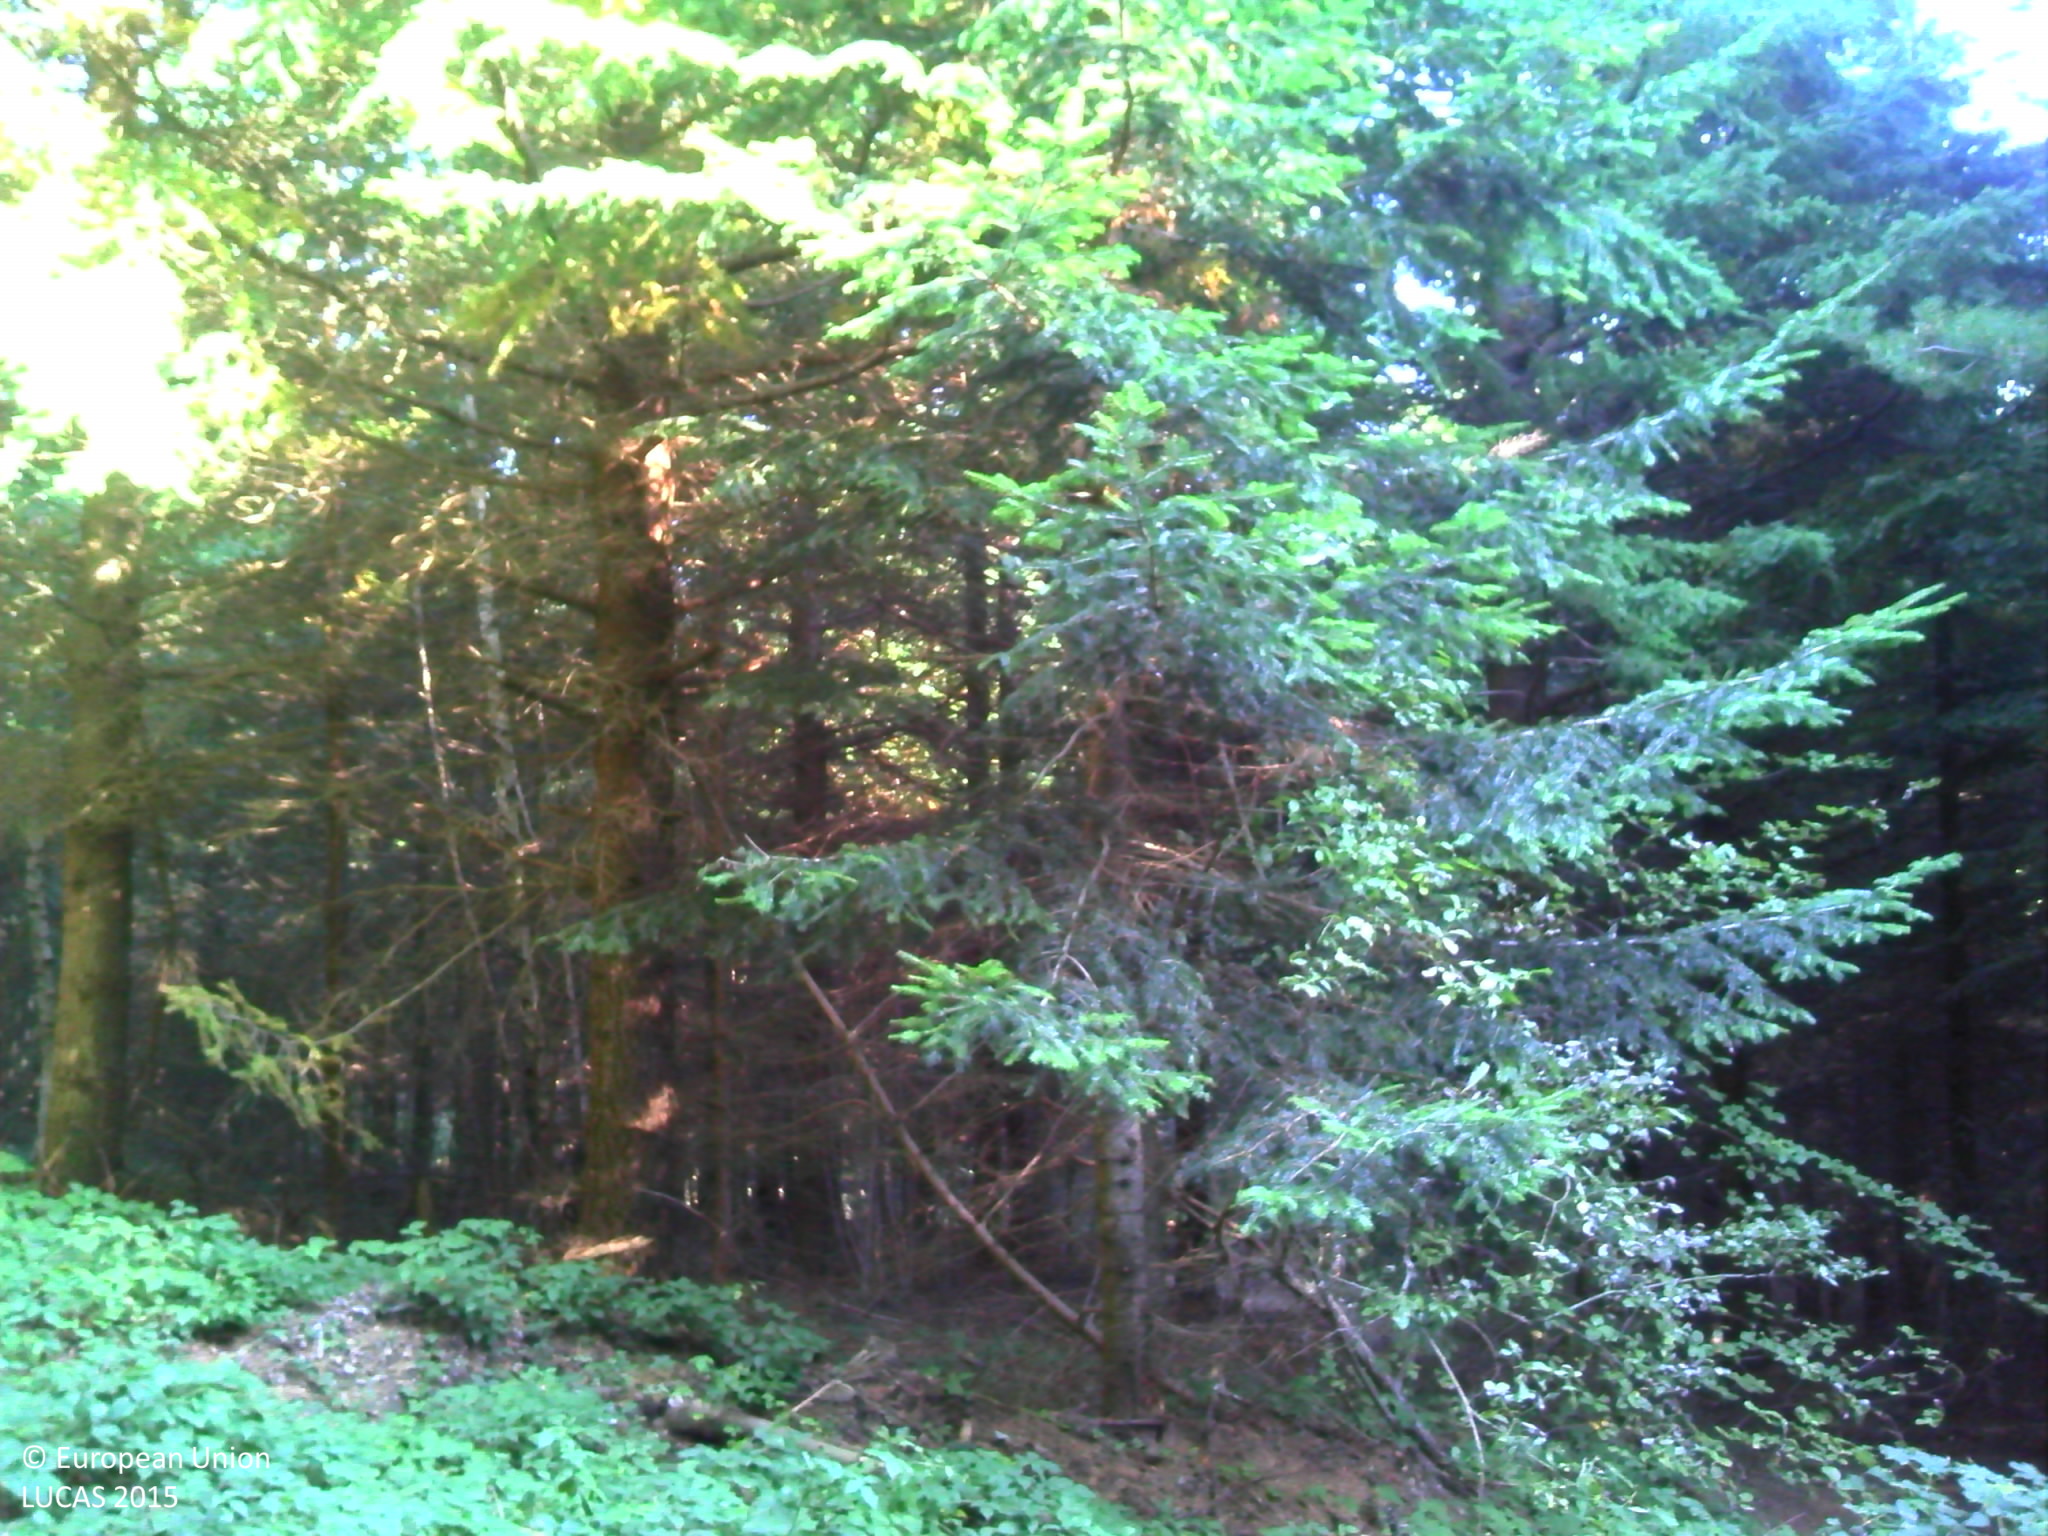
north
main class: Woodland
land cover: Spruce dominated coniferous woodland
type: alpine coniferous forest
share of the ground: > 75 %
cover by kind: coniferous forest trees 95 %, herbaceous plants 5 %
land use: Forestry
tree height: > 5 m
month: September
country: FR
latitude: 45.4190
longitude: 4.5729
